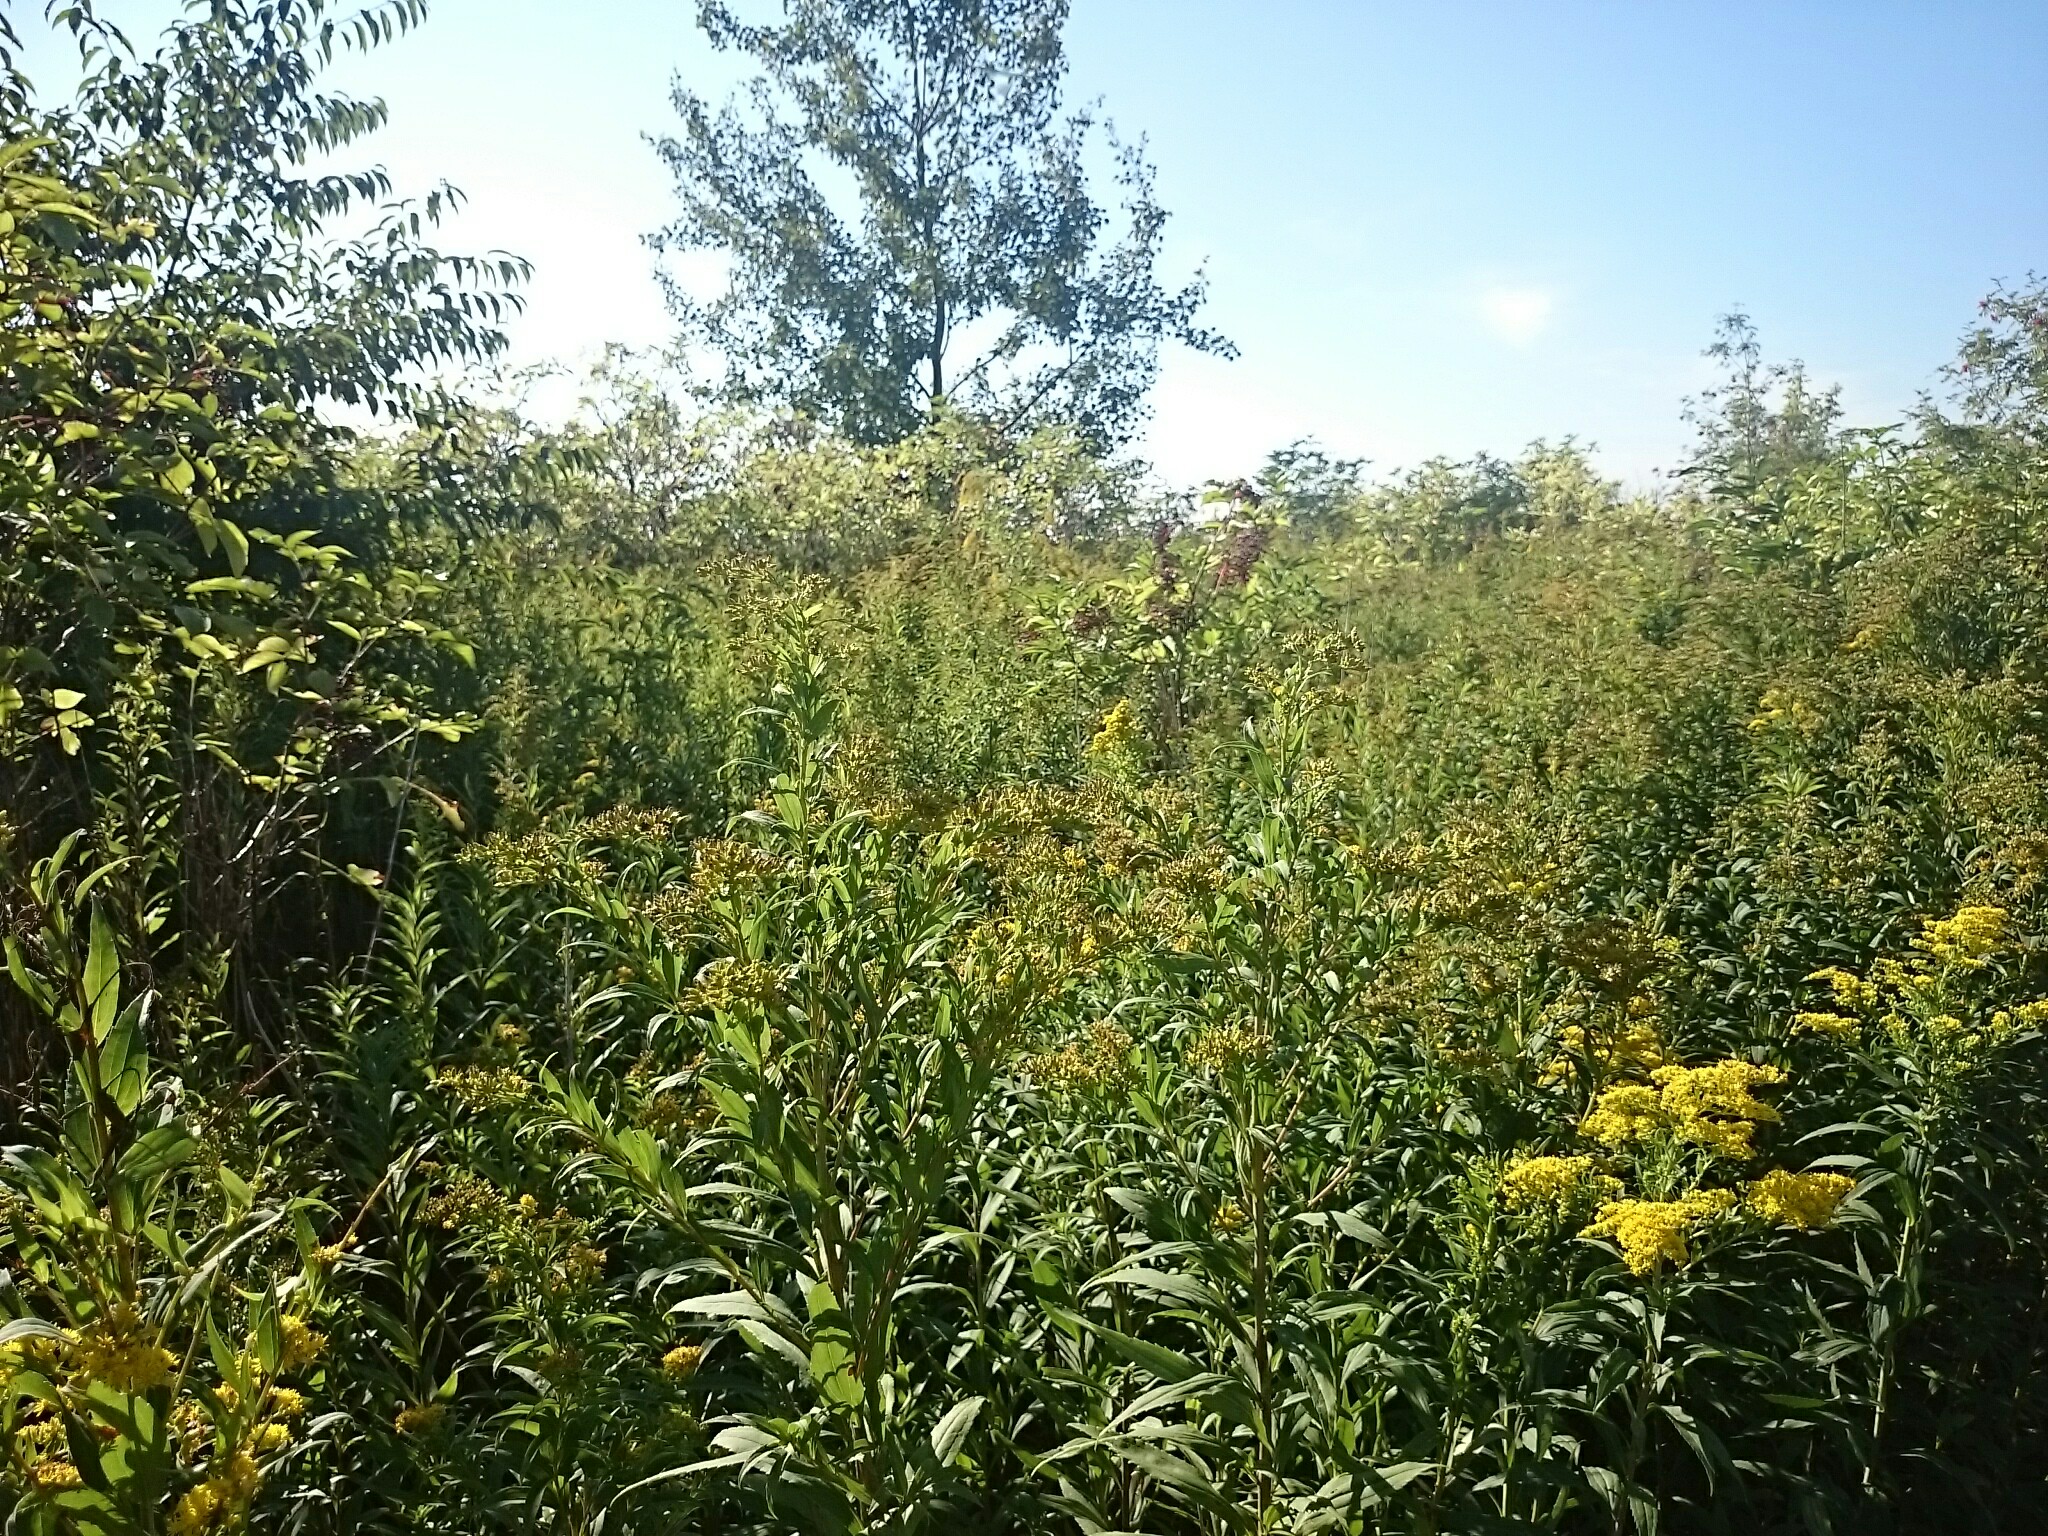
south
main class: Grassland
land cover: Grassland with sparse tree/shrub cover
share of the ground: > 75 %
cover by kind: herbaceous plants 90 %, broadleaved forest trees 5 %
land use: Semi-natural and natural areas not in use
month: September
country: PL
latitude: 51.3034
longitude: 17.3127
